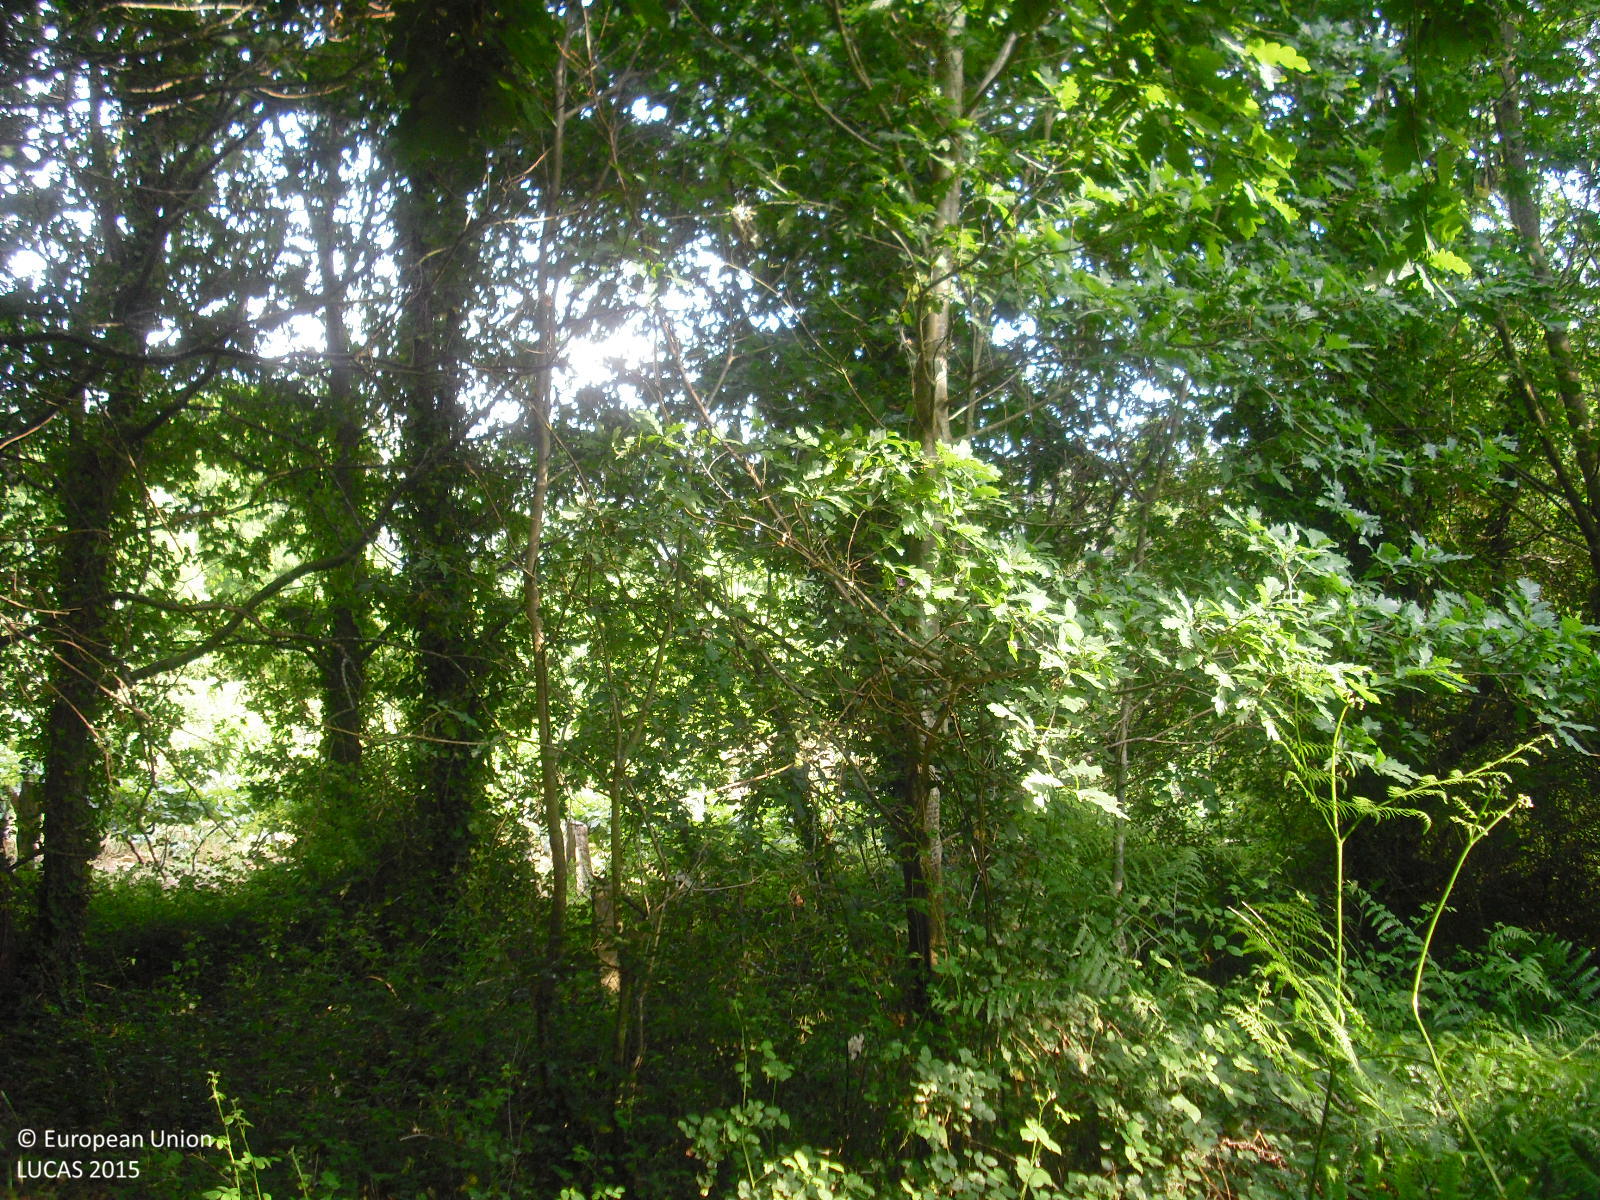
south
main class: Woodland
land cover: Broadleaved woodland
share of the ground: > 75 %
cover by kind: broadleaved forest trees 100 %
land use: Abandoned areas
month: June
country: ES
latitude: 42.1169
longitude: -8.1895
